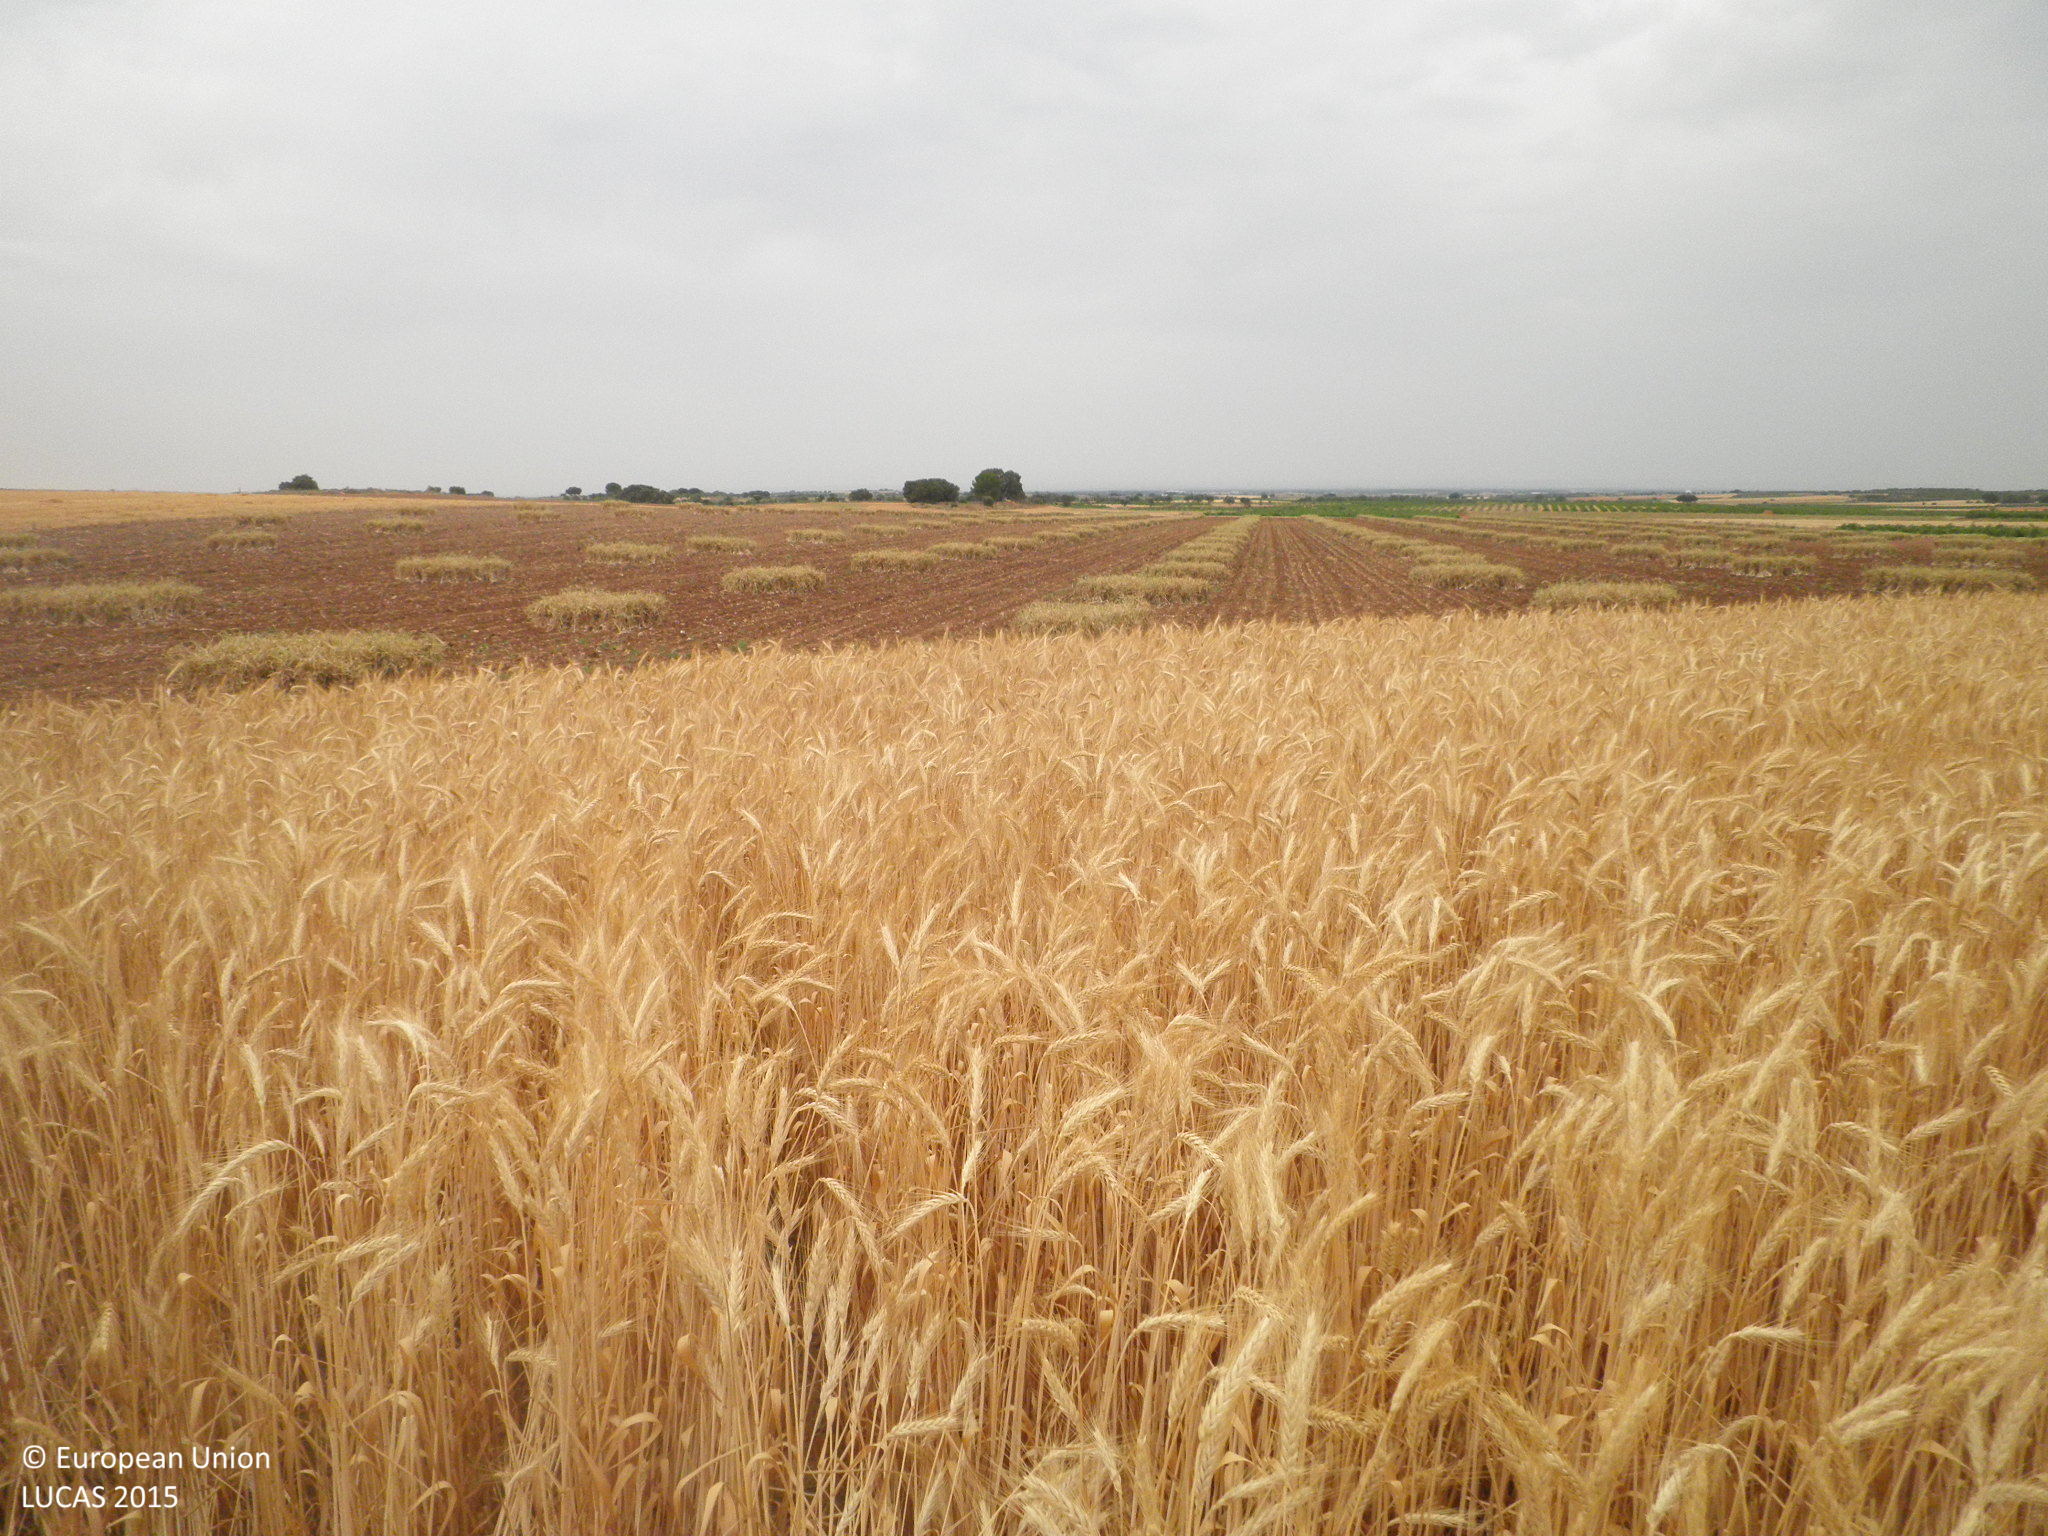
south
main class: Cropland
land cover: Durum wheat
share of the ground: > 75 %
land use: Agriculture (excluding fallow land and kitchen gardens)
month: July
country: ES
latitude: 39.4993
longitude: -2.6541
